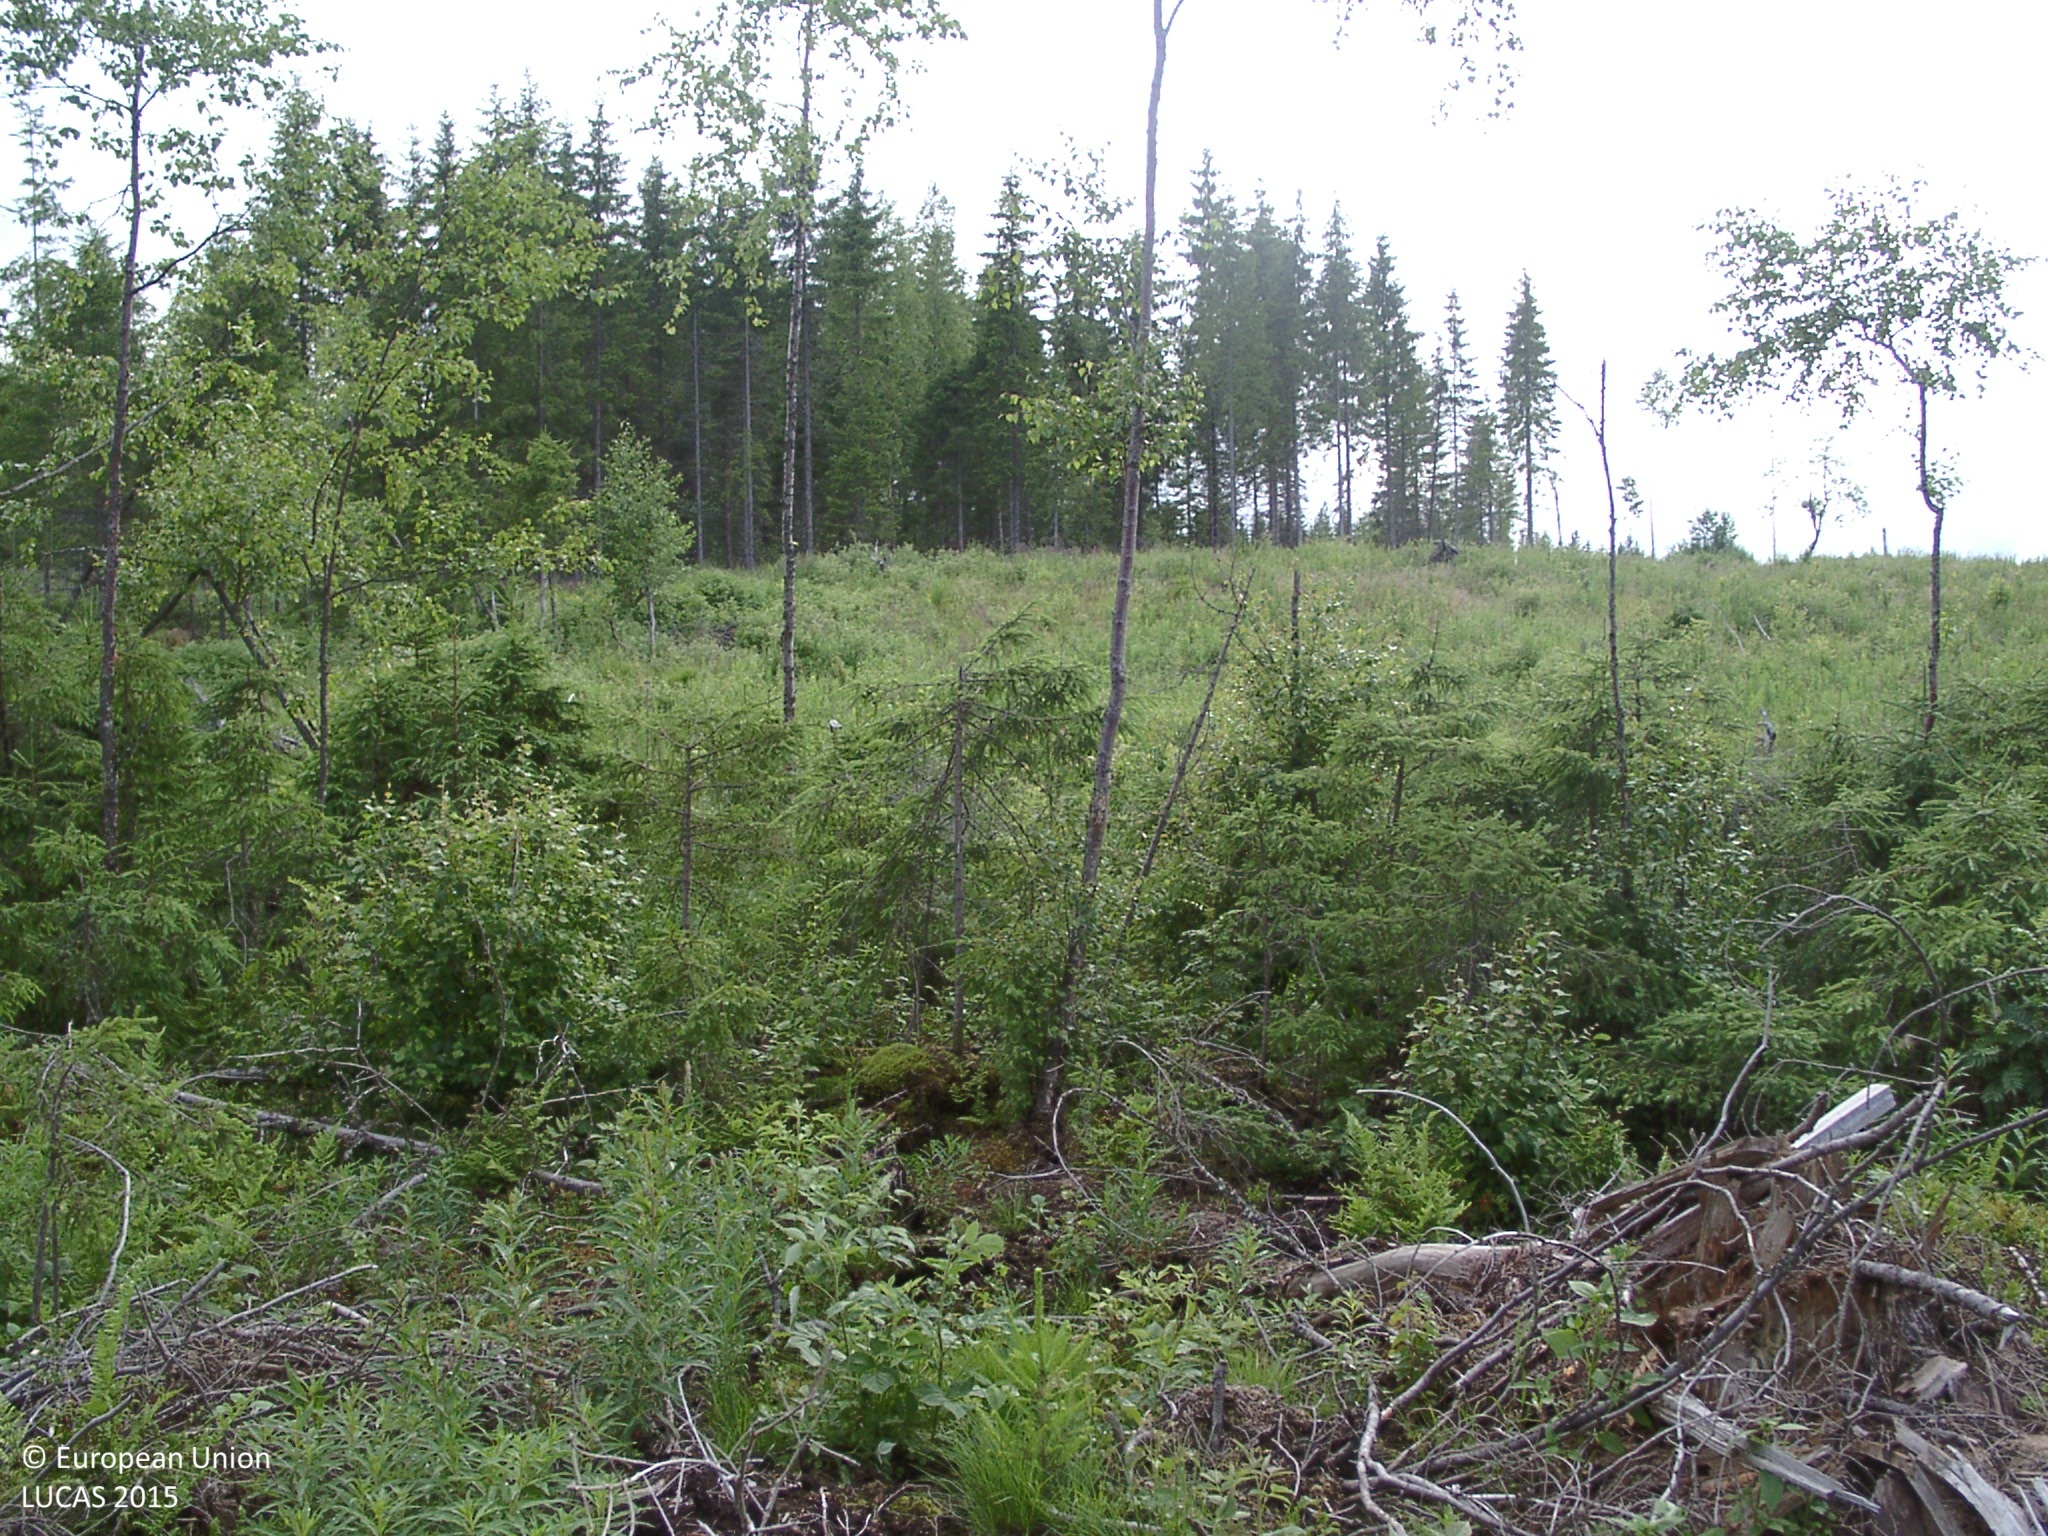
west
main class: Shrubland
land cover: Shrubland with sparse tree cover
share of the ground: 10 - 25 %
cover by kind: herbaceous plants 40 %, shrubs 15 %, broadleaved forest trees 5 %, unconsolidated bare surface 5 %
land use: Forestry
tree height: < 5 m
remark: Nursery
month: July
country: FI
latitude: 62.0783
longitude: 25.3304
